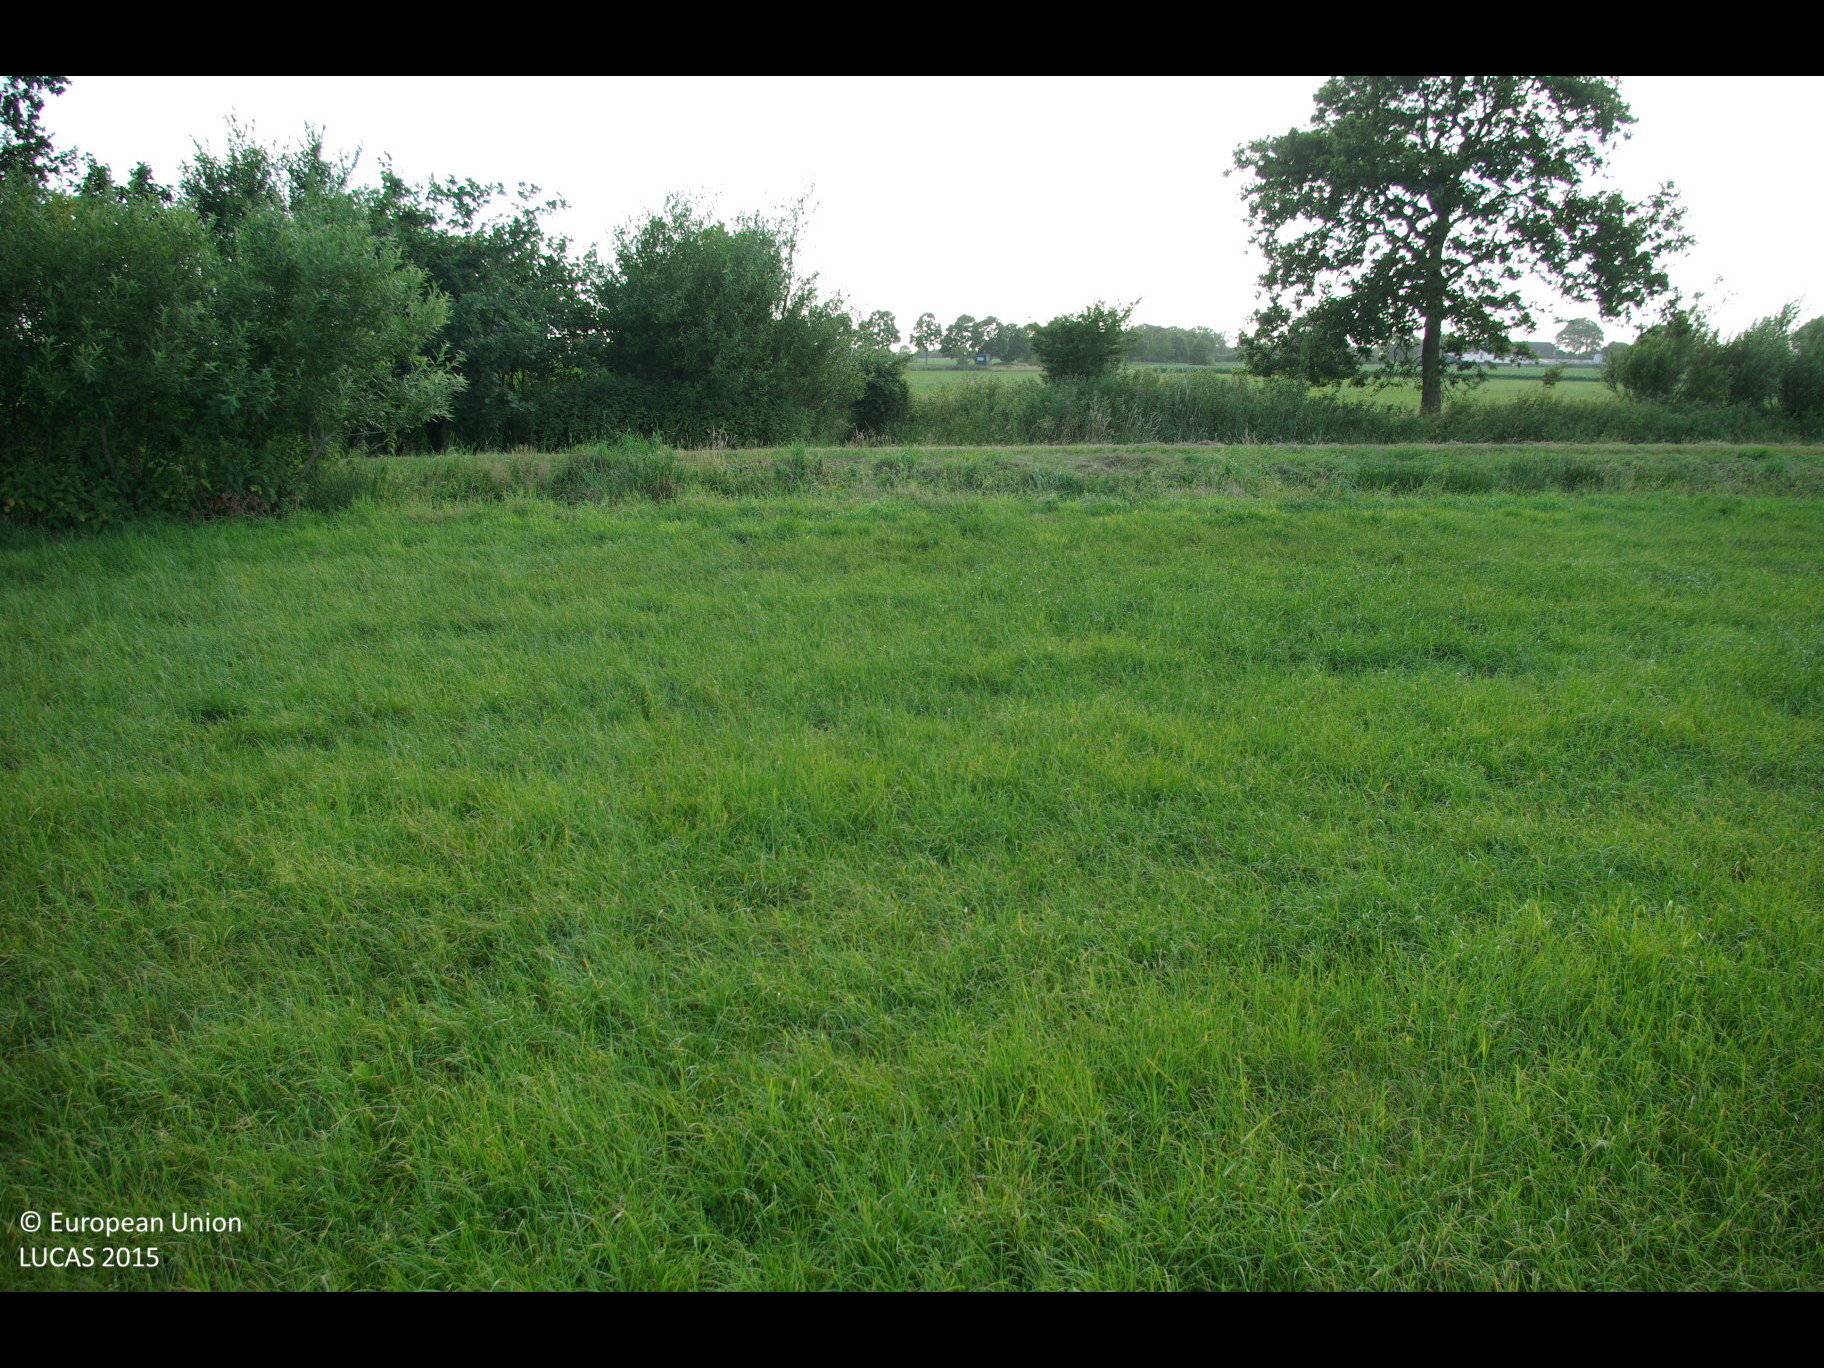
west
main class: Grassland
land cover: Grassland without tree/shrub cover
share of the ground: > 75 %
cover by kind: herbaceous plants 100 %
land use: Agriculture (excluding fallow land and kitchen gardens)
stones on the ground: < 10 %
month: July
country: DE
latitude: 54.6580
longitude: 9.3029
